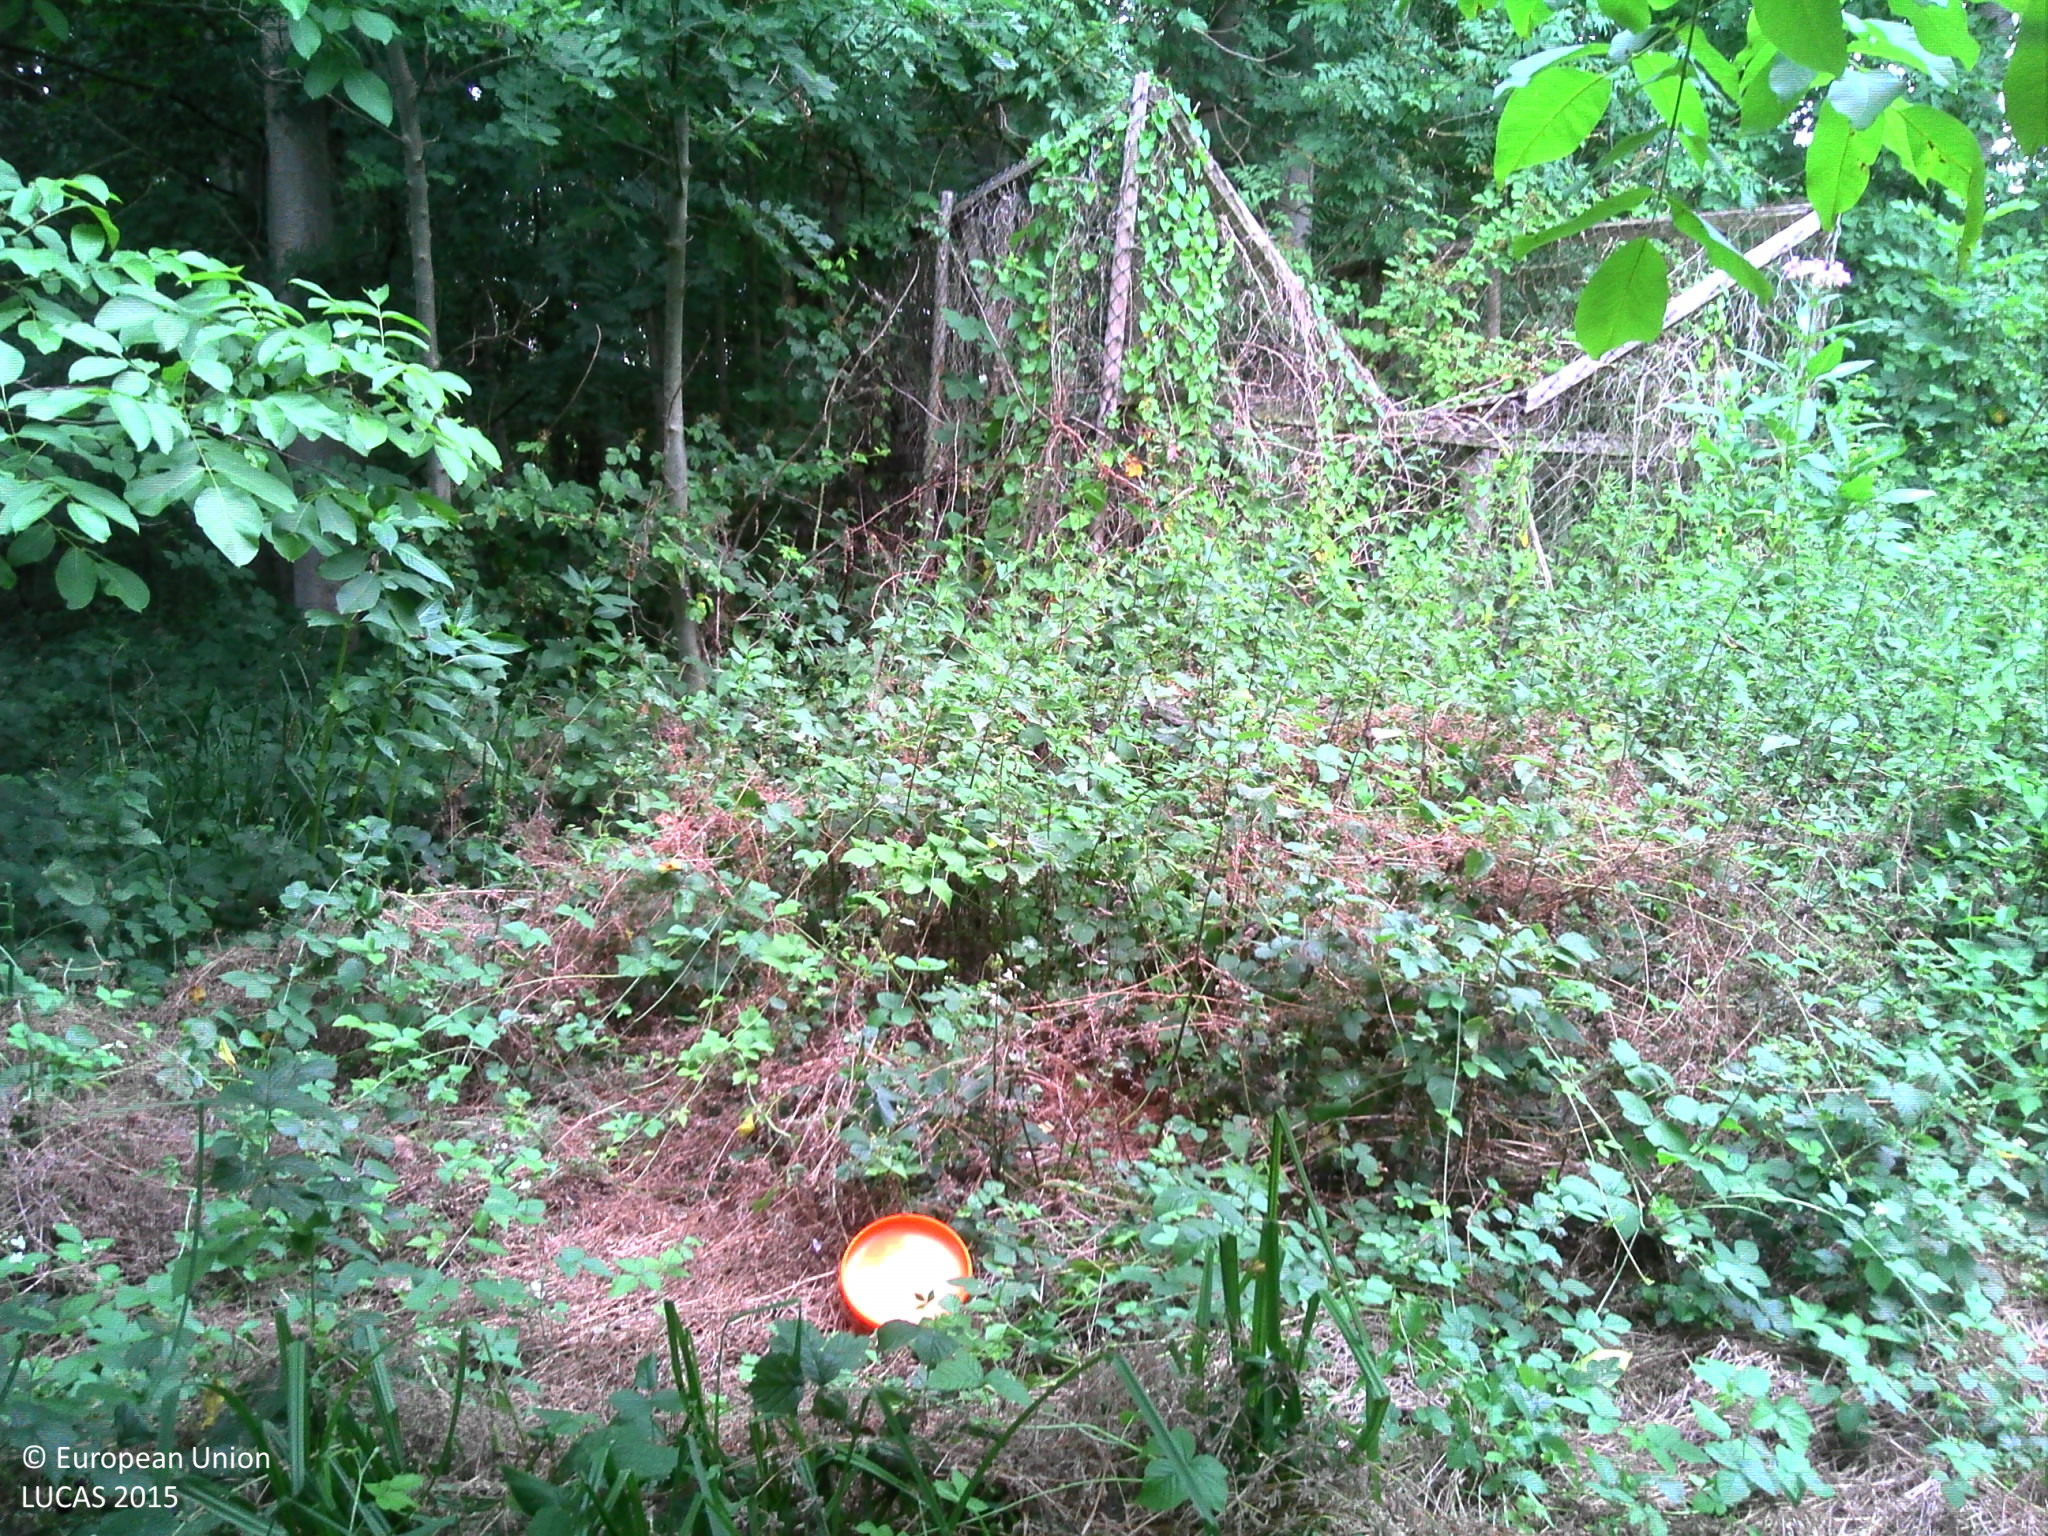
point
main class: Grassland
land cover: Spontaneously vegetated surfaces
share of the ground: > 75 %
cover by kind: herbaceous plants 100 %
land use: Semi-natural and natural areas not in use
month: July
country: FR
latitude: 48.6300
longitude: 7.6263
